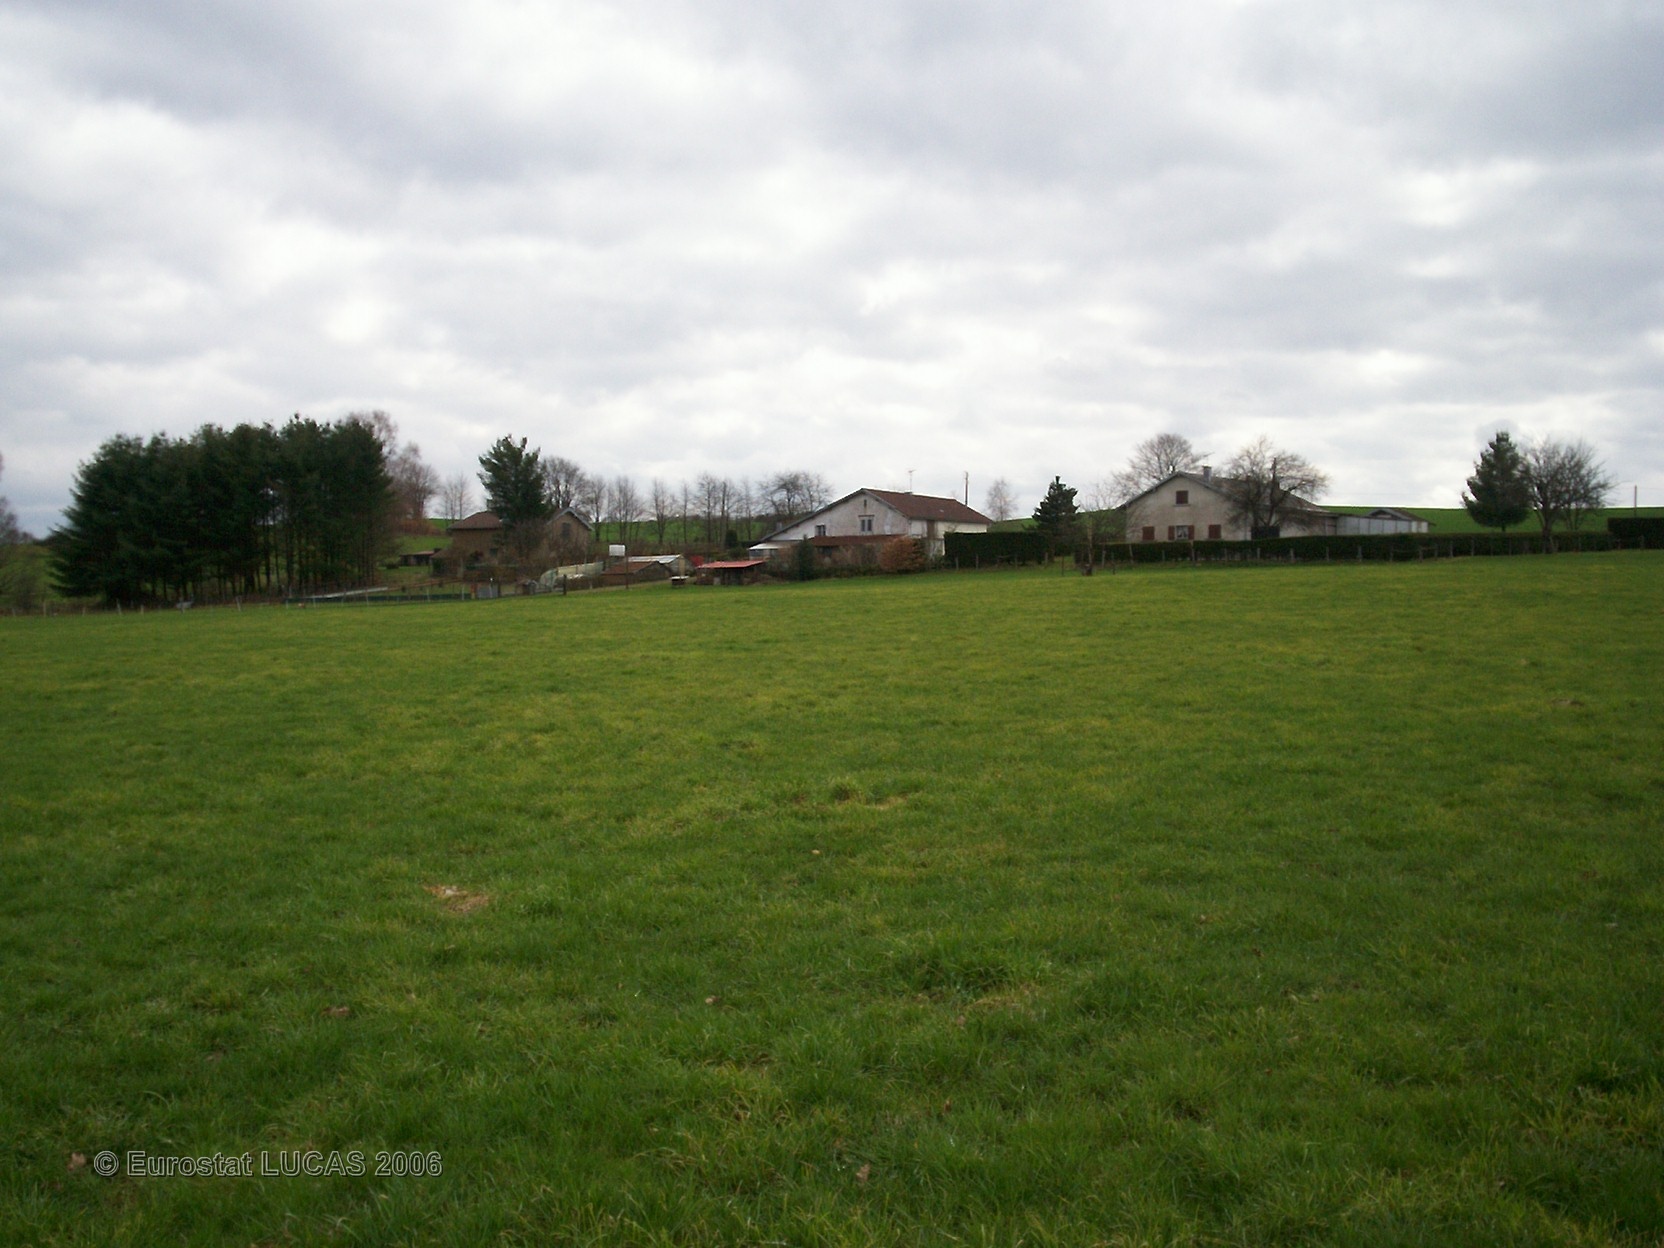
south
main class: Grassland
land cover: Grassland without tree/shrub cover
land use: Agriculture (excluding fallow land and kitchen gardens)
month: April
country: FR
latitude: 48.0240
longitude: 6.5013
